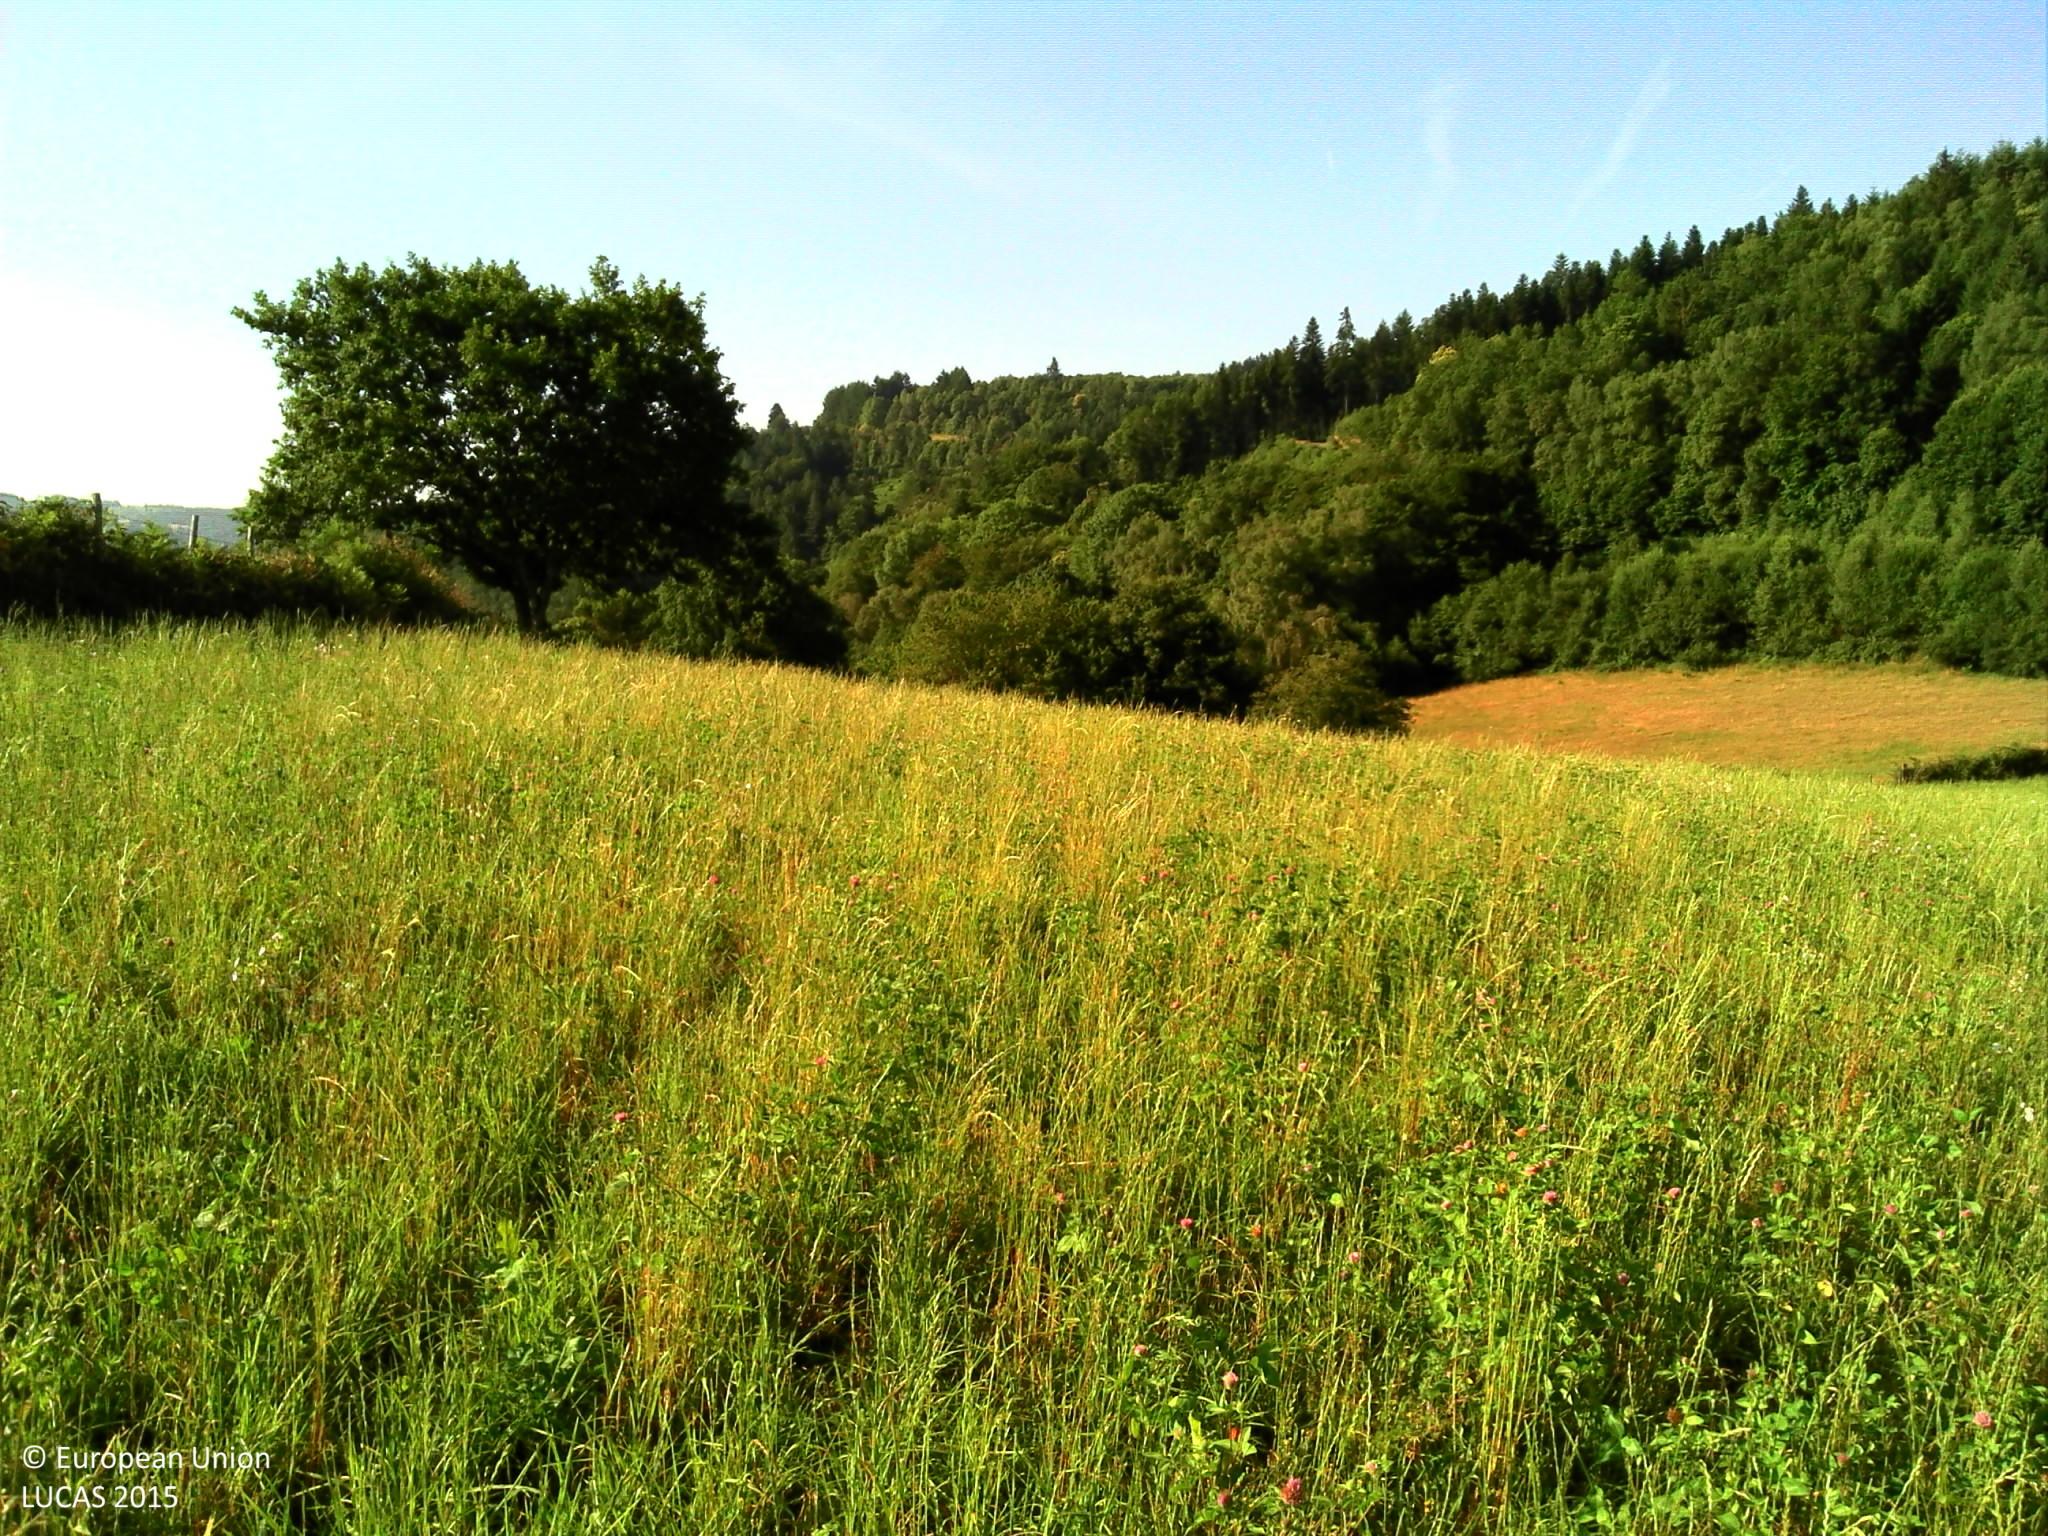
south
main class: Cropland
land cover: Temporary grasslands
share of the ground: 50 - 75 %
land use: Agriculture (excluding fallow land and kitchen gardens)
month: July
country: FR
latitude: 45.7250
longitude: 1.7580
